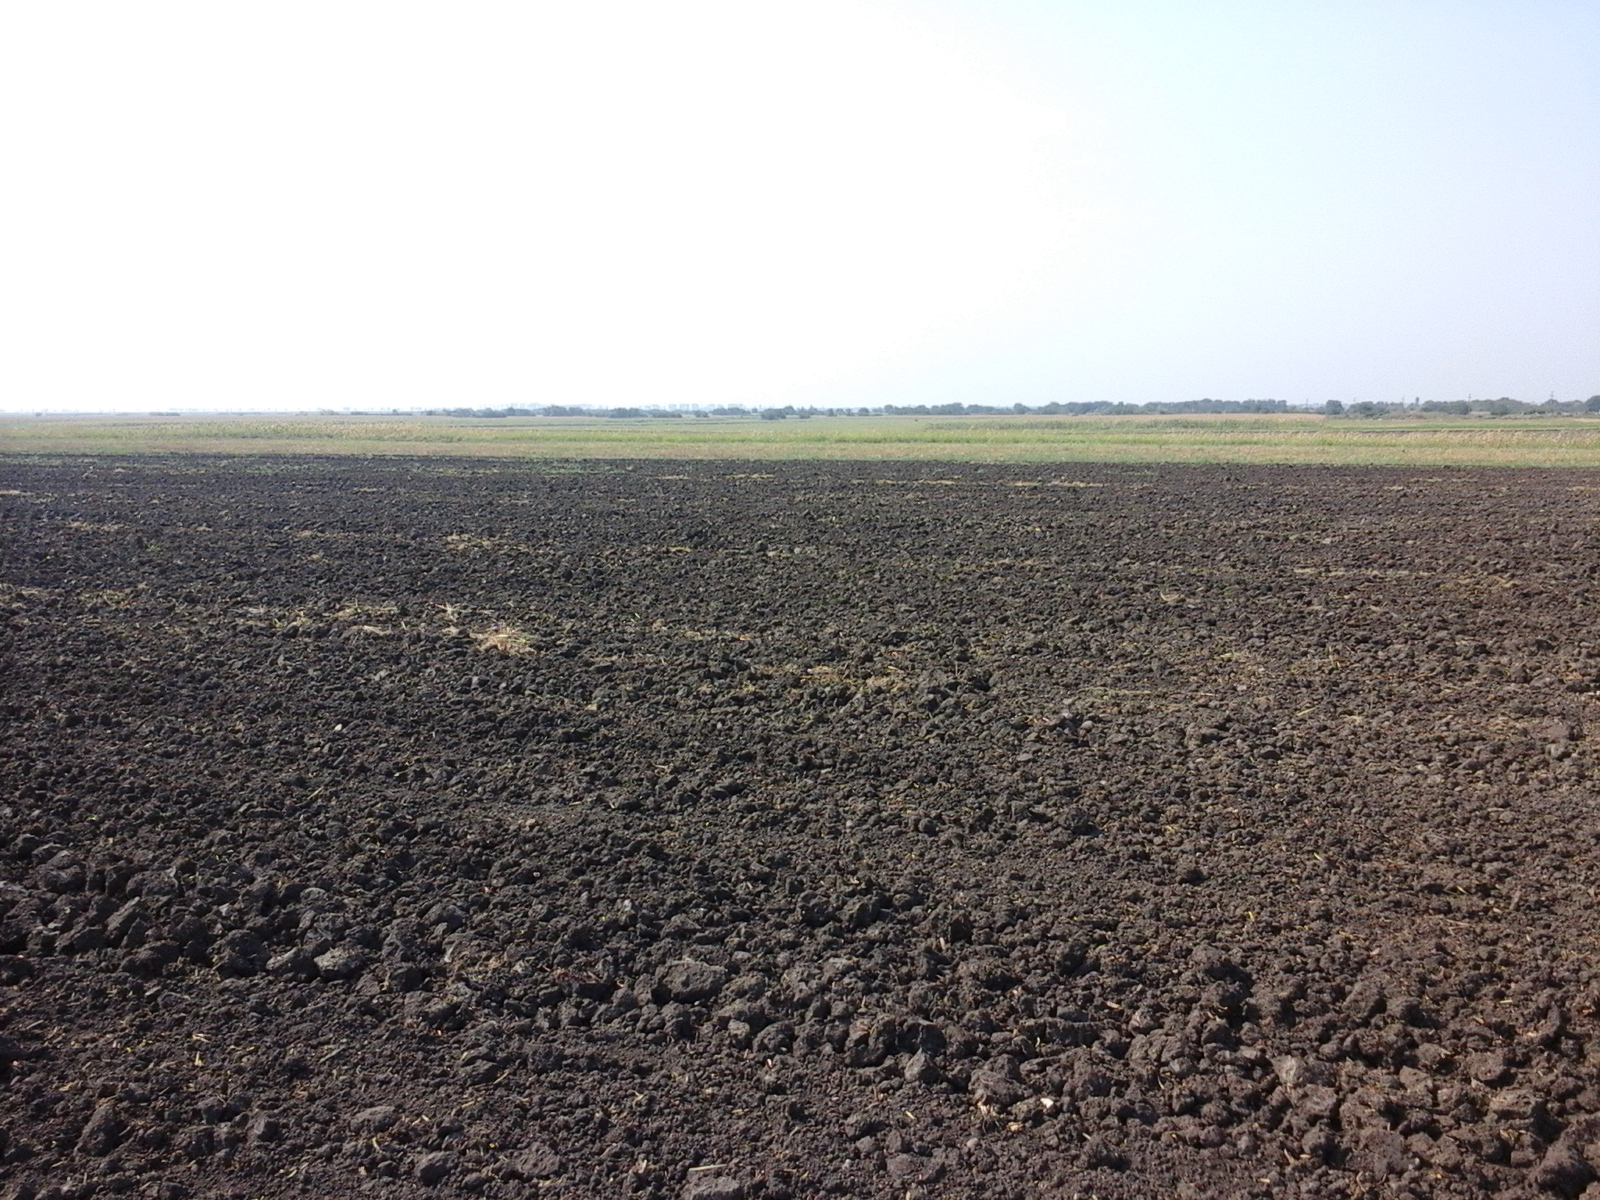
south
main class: Cropland
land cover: Common wheat
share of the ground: < 10 %
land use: Agriculture (excluding fallow land and kitchen gardens)
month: August
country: RO
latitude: 44.0494
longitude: 23.4917
